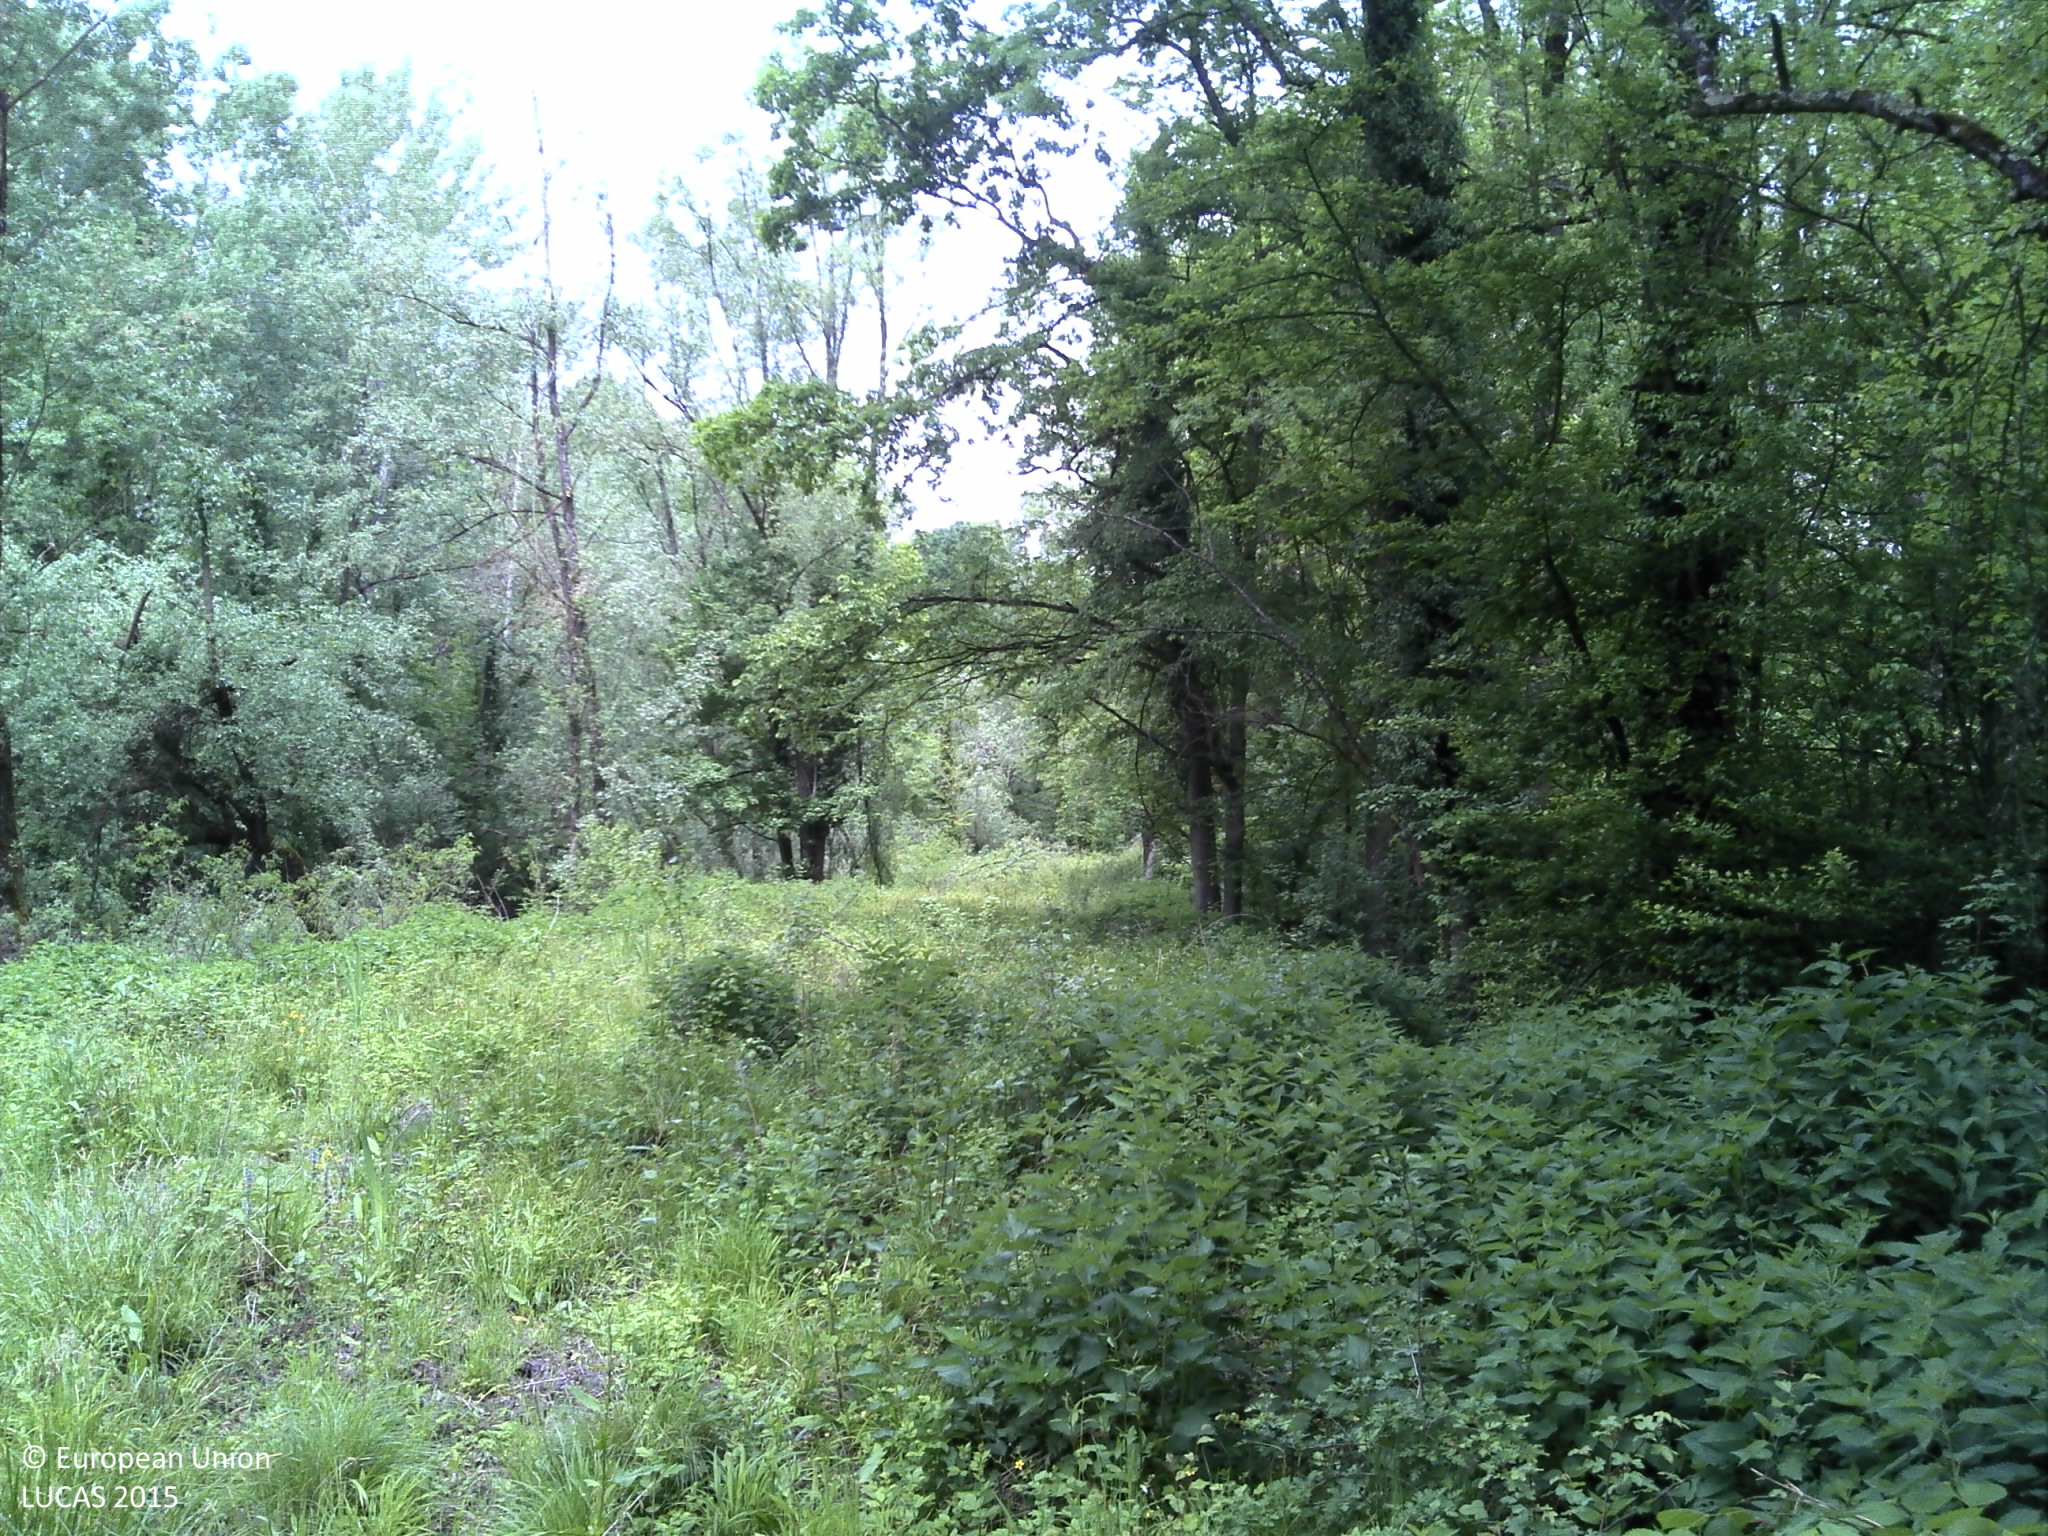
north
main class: Woodland
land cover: Broadleaved woodland
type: mesophytic deciduous forest
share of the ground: > 75 %
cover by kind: broadleaved forest trees 100 %
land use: Forestry
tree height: > 5 m
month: May
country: HR
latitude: 45.0254
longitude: 18.8267
